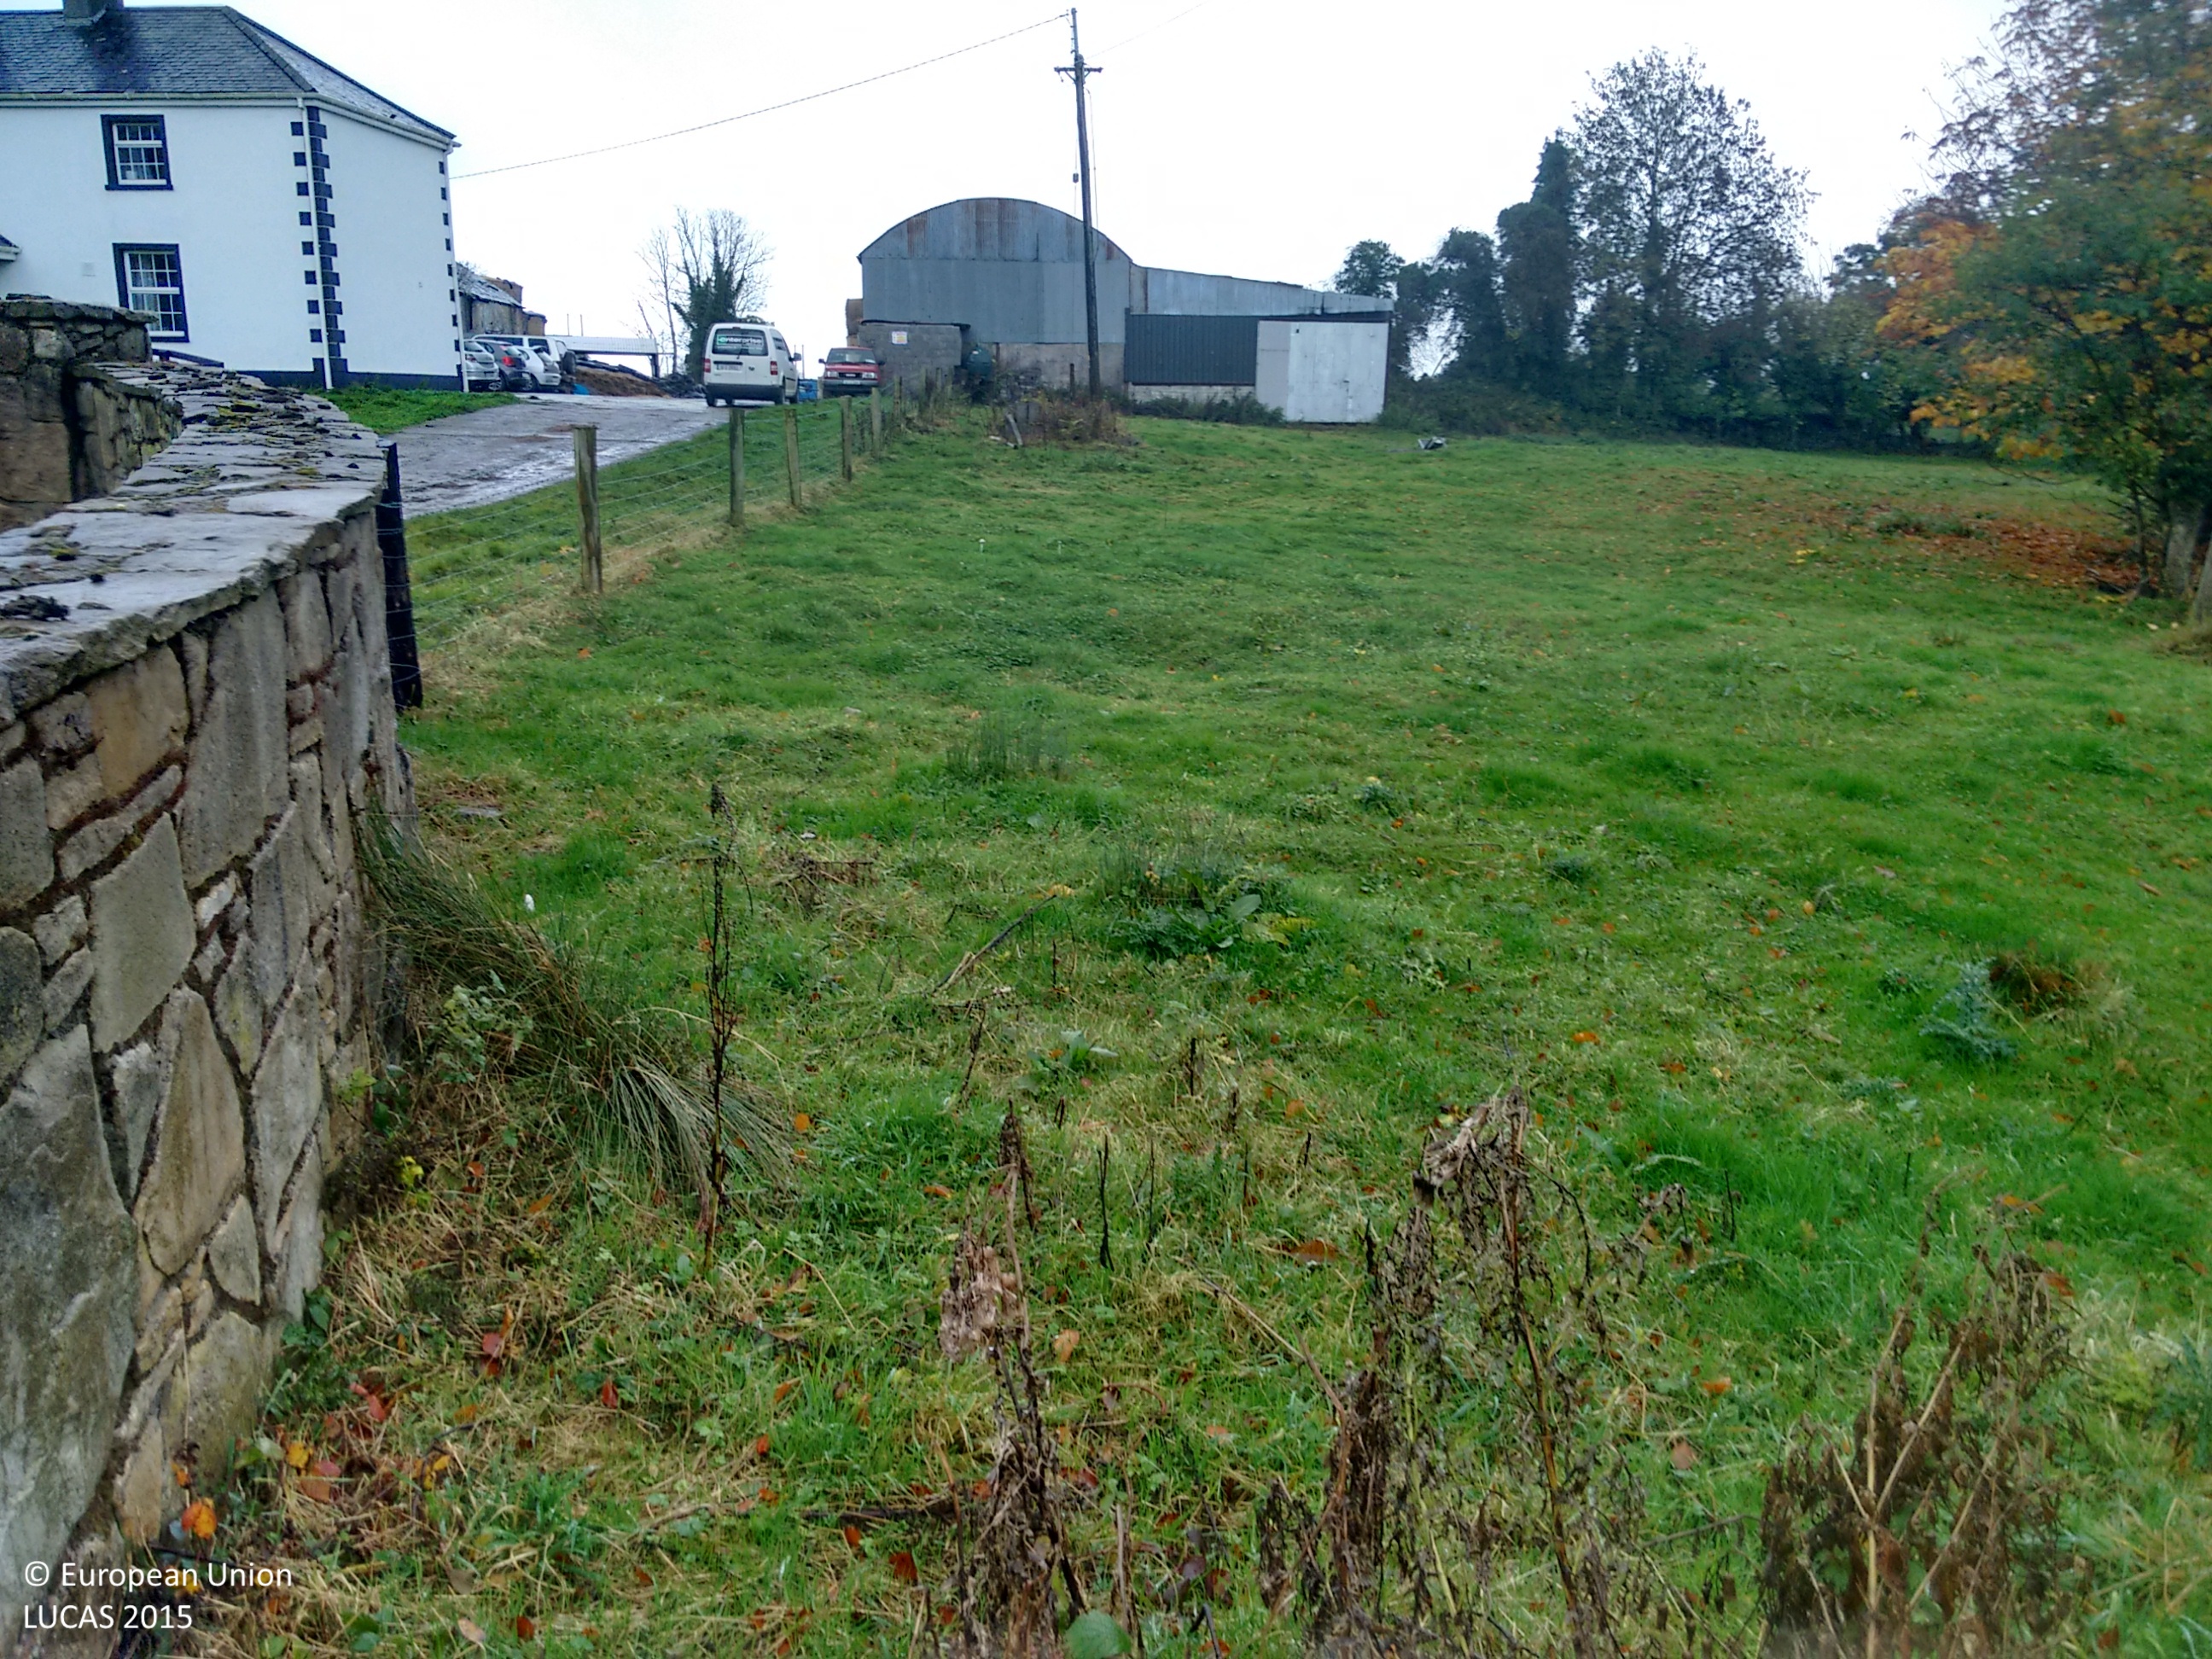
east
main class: Grassland
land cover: Grassland without tree/shrub cover
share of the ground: > 75 %
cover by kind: herbaceous plants 50 %, consolidated bare surface 15 %
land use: Agriculture (excluding fallow land and kitchen gardens)
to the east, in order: Grassland without tree/shrub cover; Electric lines; Grassland without tree/shrub cover; Artificial constructions in urban areas; Grassland without tree/shrub cover; Fences; Ditches and canals; Fences; Grassland without tree/shrub cover; Fences; Grassland without tree/shrub cover
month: October
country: IE
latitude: 52.9601
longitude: -7.6251
